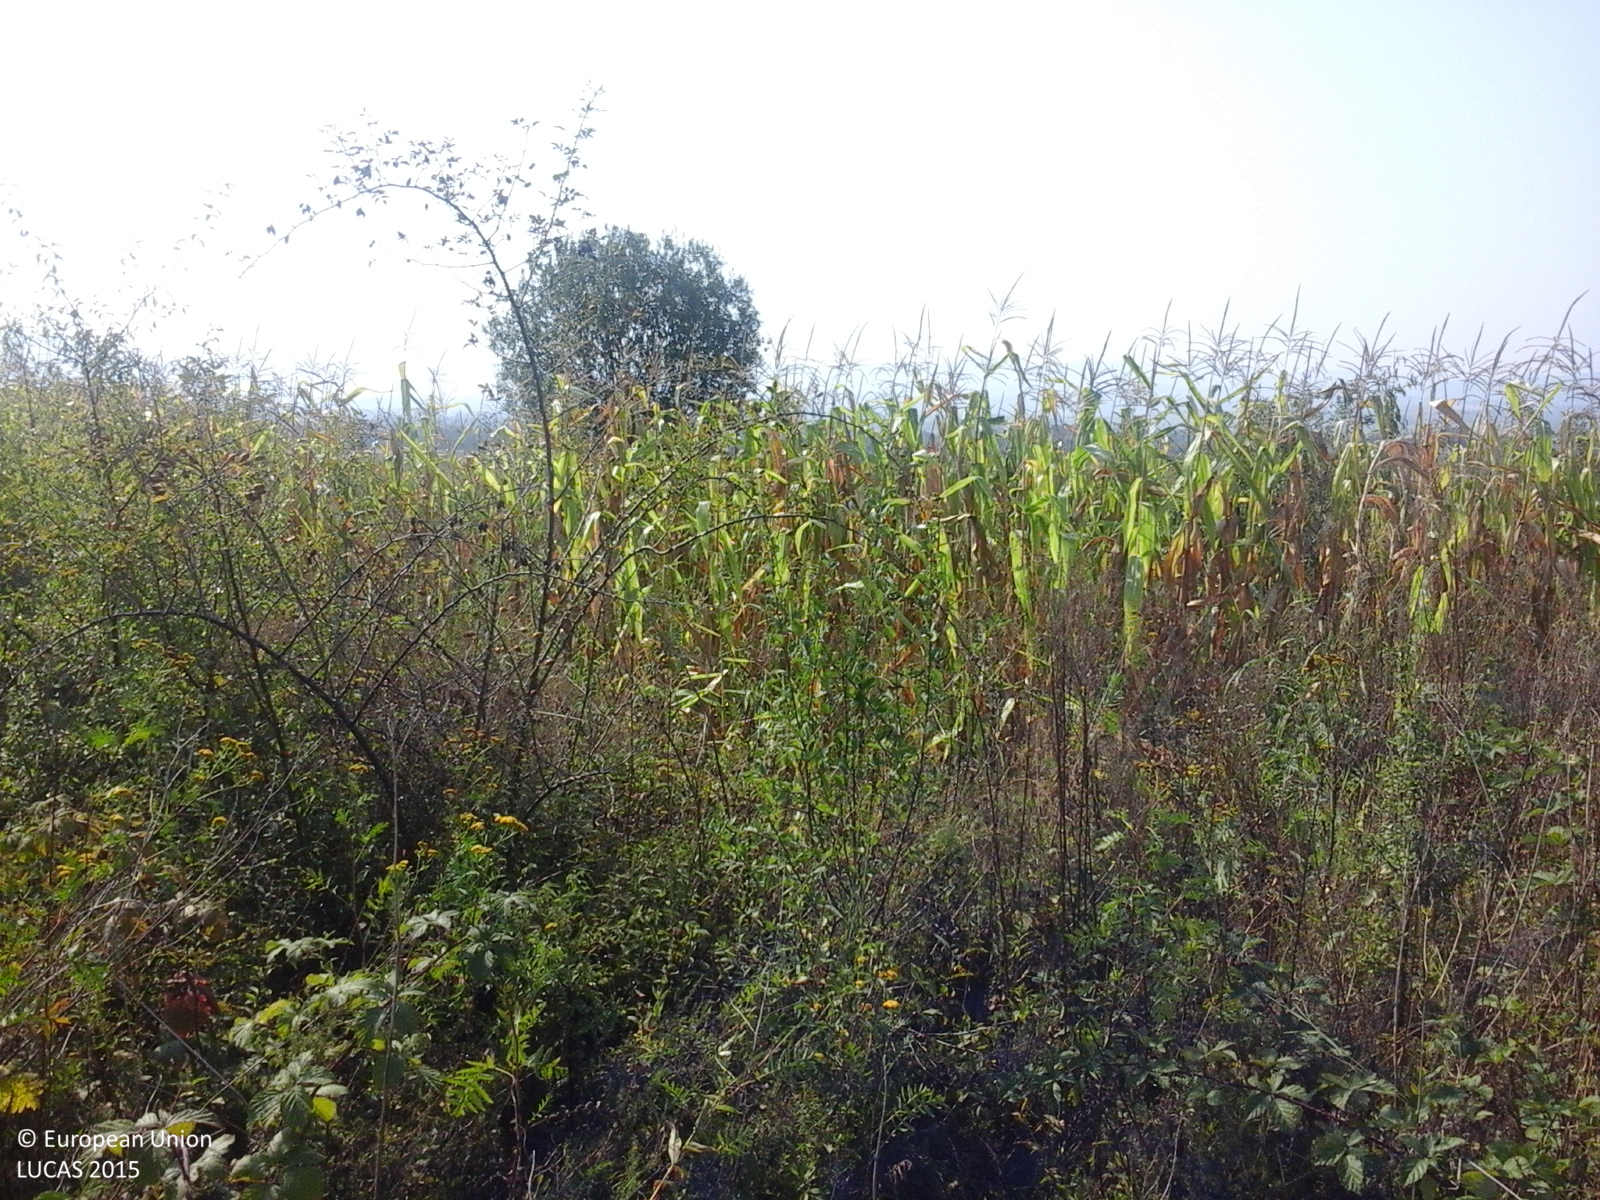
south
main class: Grassland
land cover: Grassland with sparse tree/shrub cover
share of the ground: > 75 %
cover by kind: herbaceous plants 85 %, shrubs 10 %, broadleaved forest trees 5 %
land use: Agriculture (excluding fallow land and kitchen gardens)
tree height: < 5 m
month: August
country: RO
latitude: 46.3128
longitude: 22.2930
